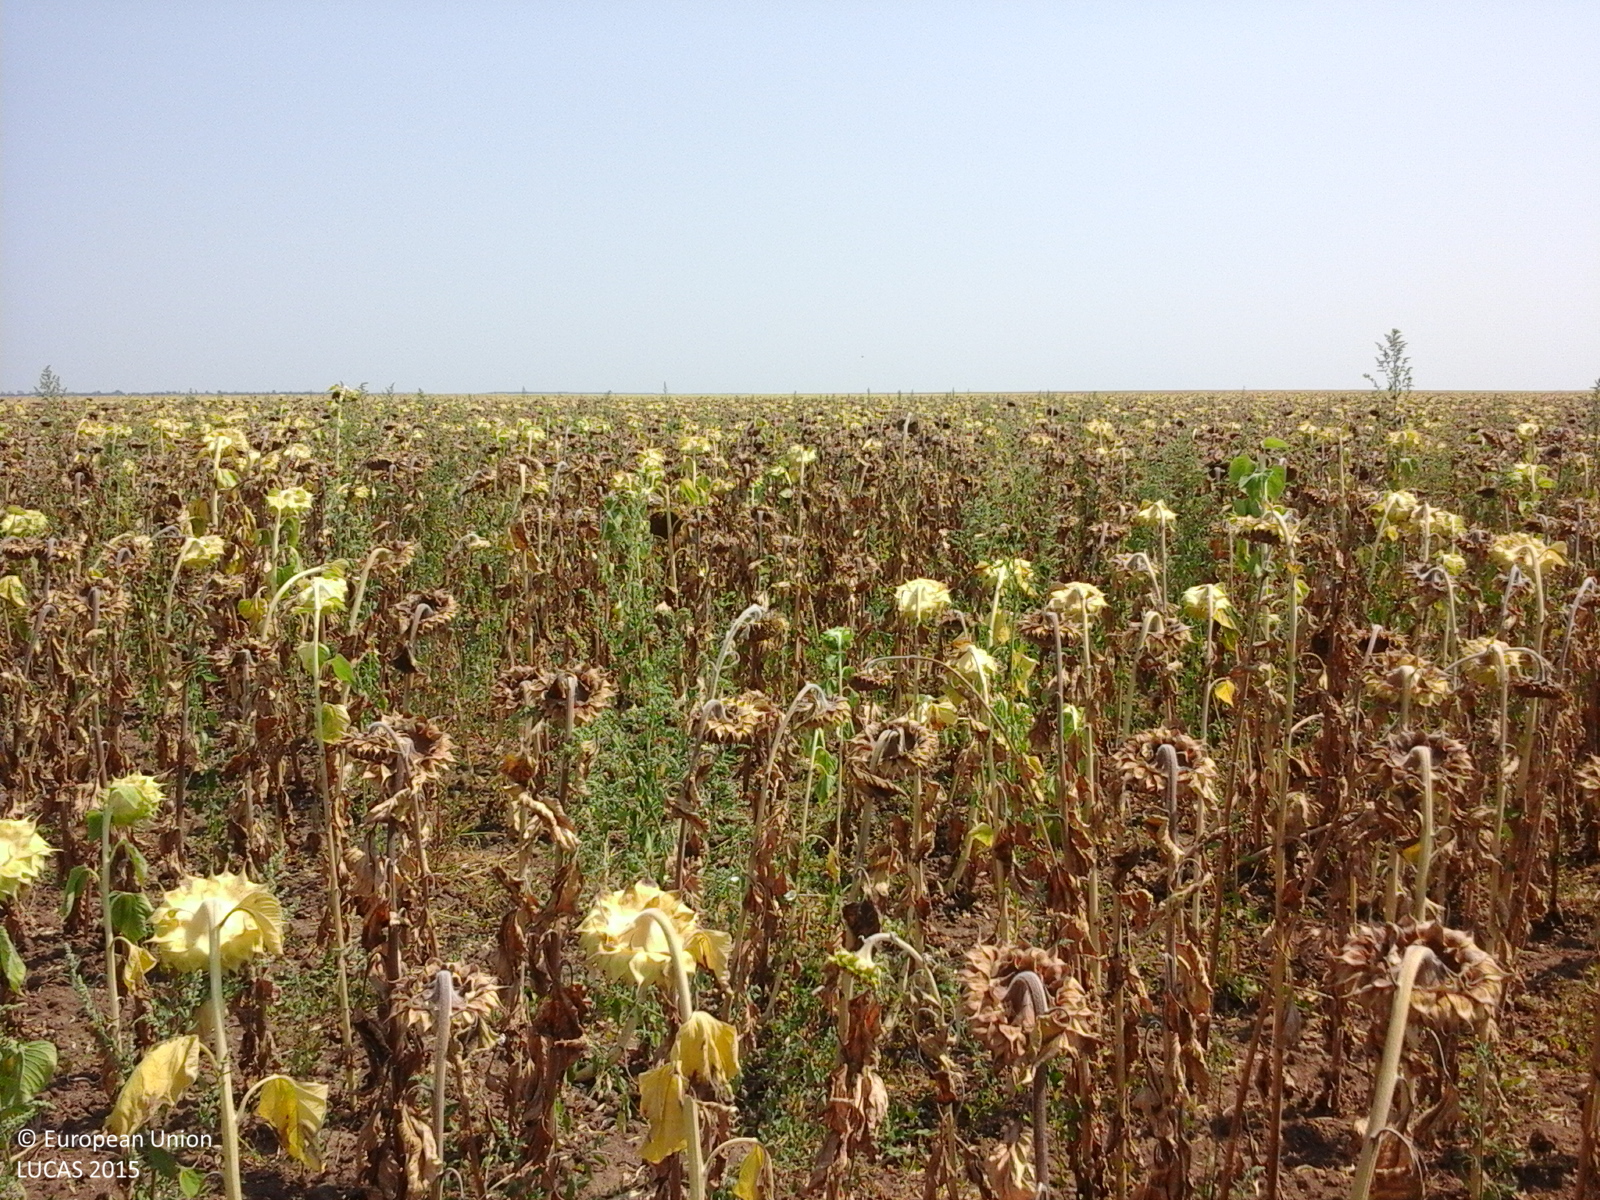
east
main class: Cropland
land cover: Sunflower
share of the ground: > 75 %
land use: Agriculture (excluding fallow land and kitchen gardens)
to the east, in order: Sunflower
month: August
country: RO
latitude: 44.2763
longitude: 23.2915
